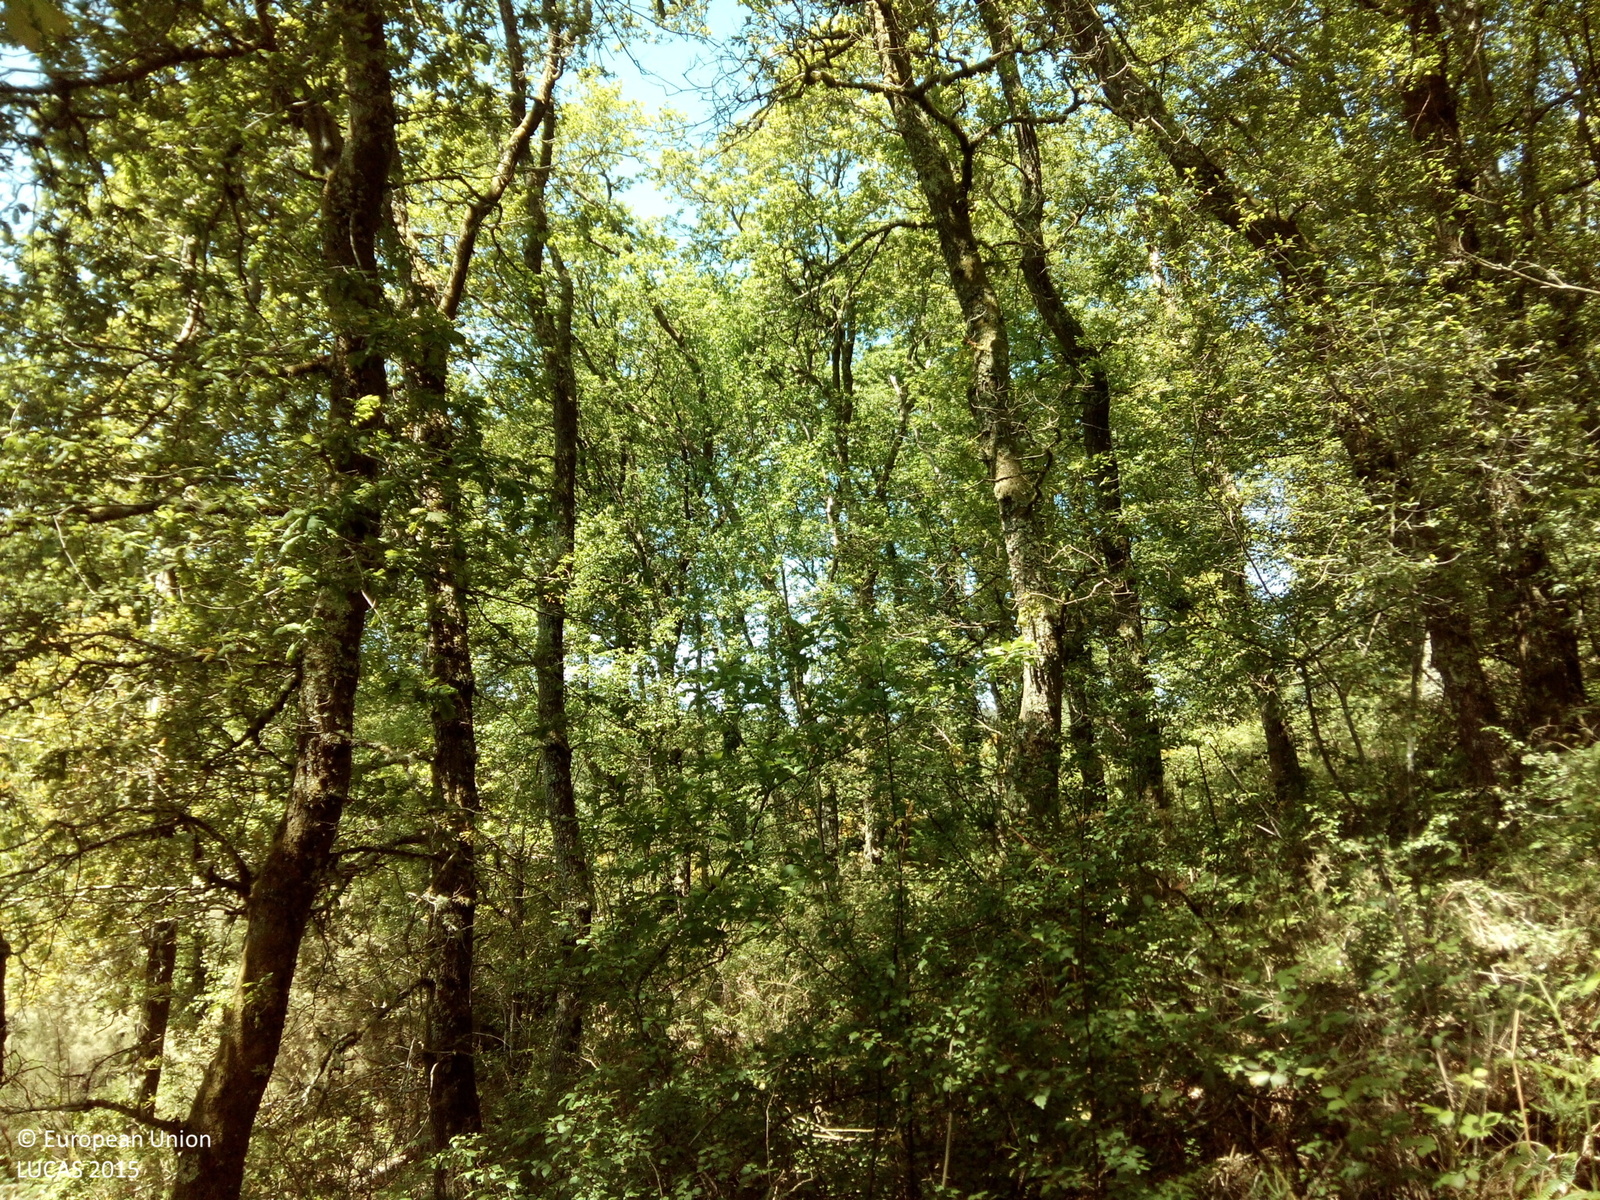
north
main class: Woodland
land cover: Broadleaved woodland
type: acidophilous oak and oak-birch forest
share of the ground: > 75 %
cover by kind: broadleaved forest trees 100 %
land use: Forestry
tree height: > 5 m
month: May
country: ES
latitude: 42.6015
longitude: -8.3657
